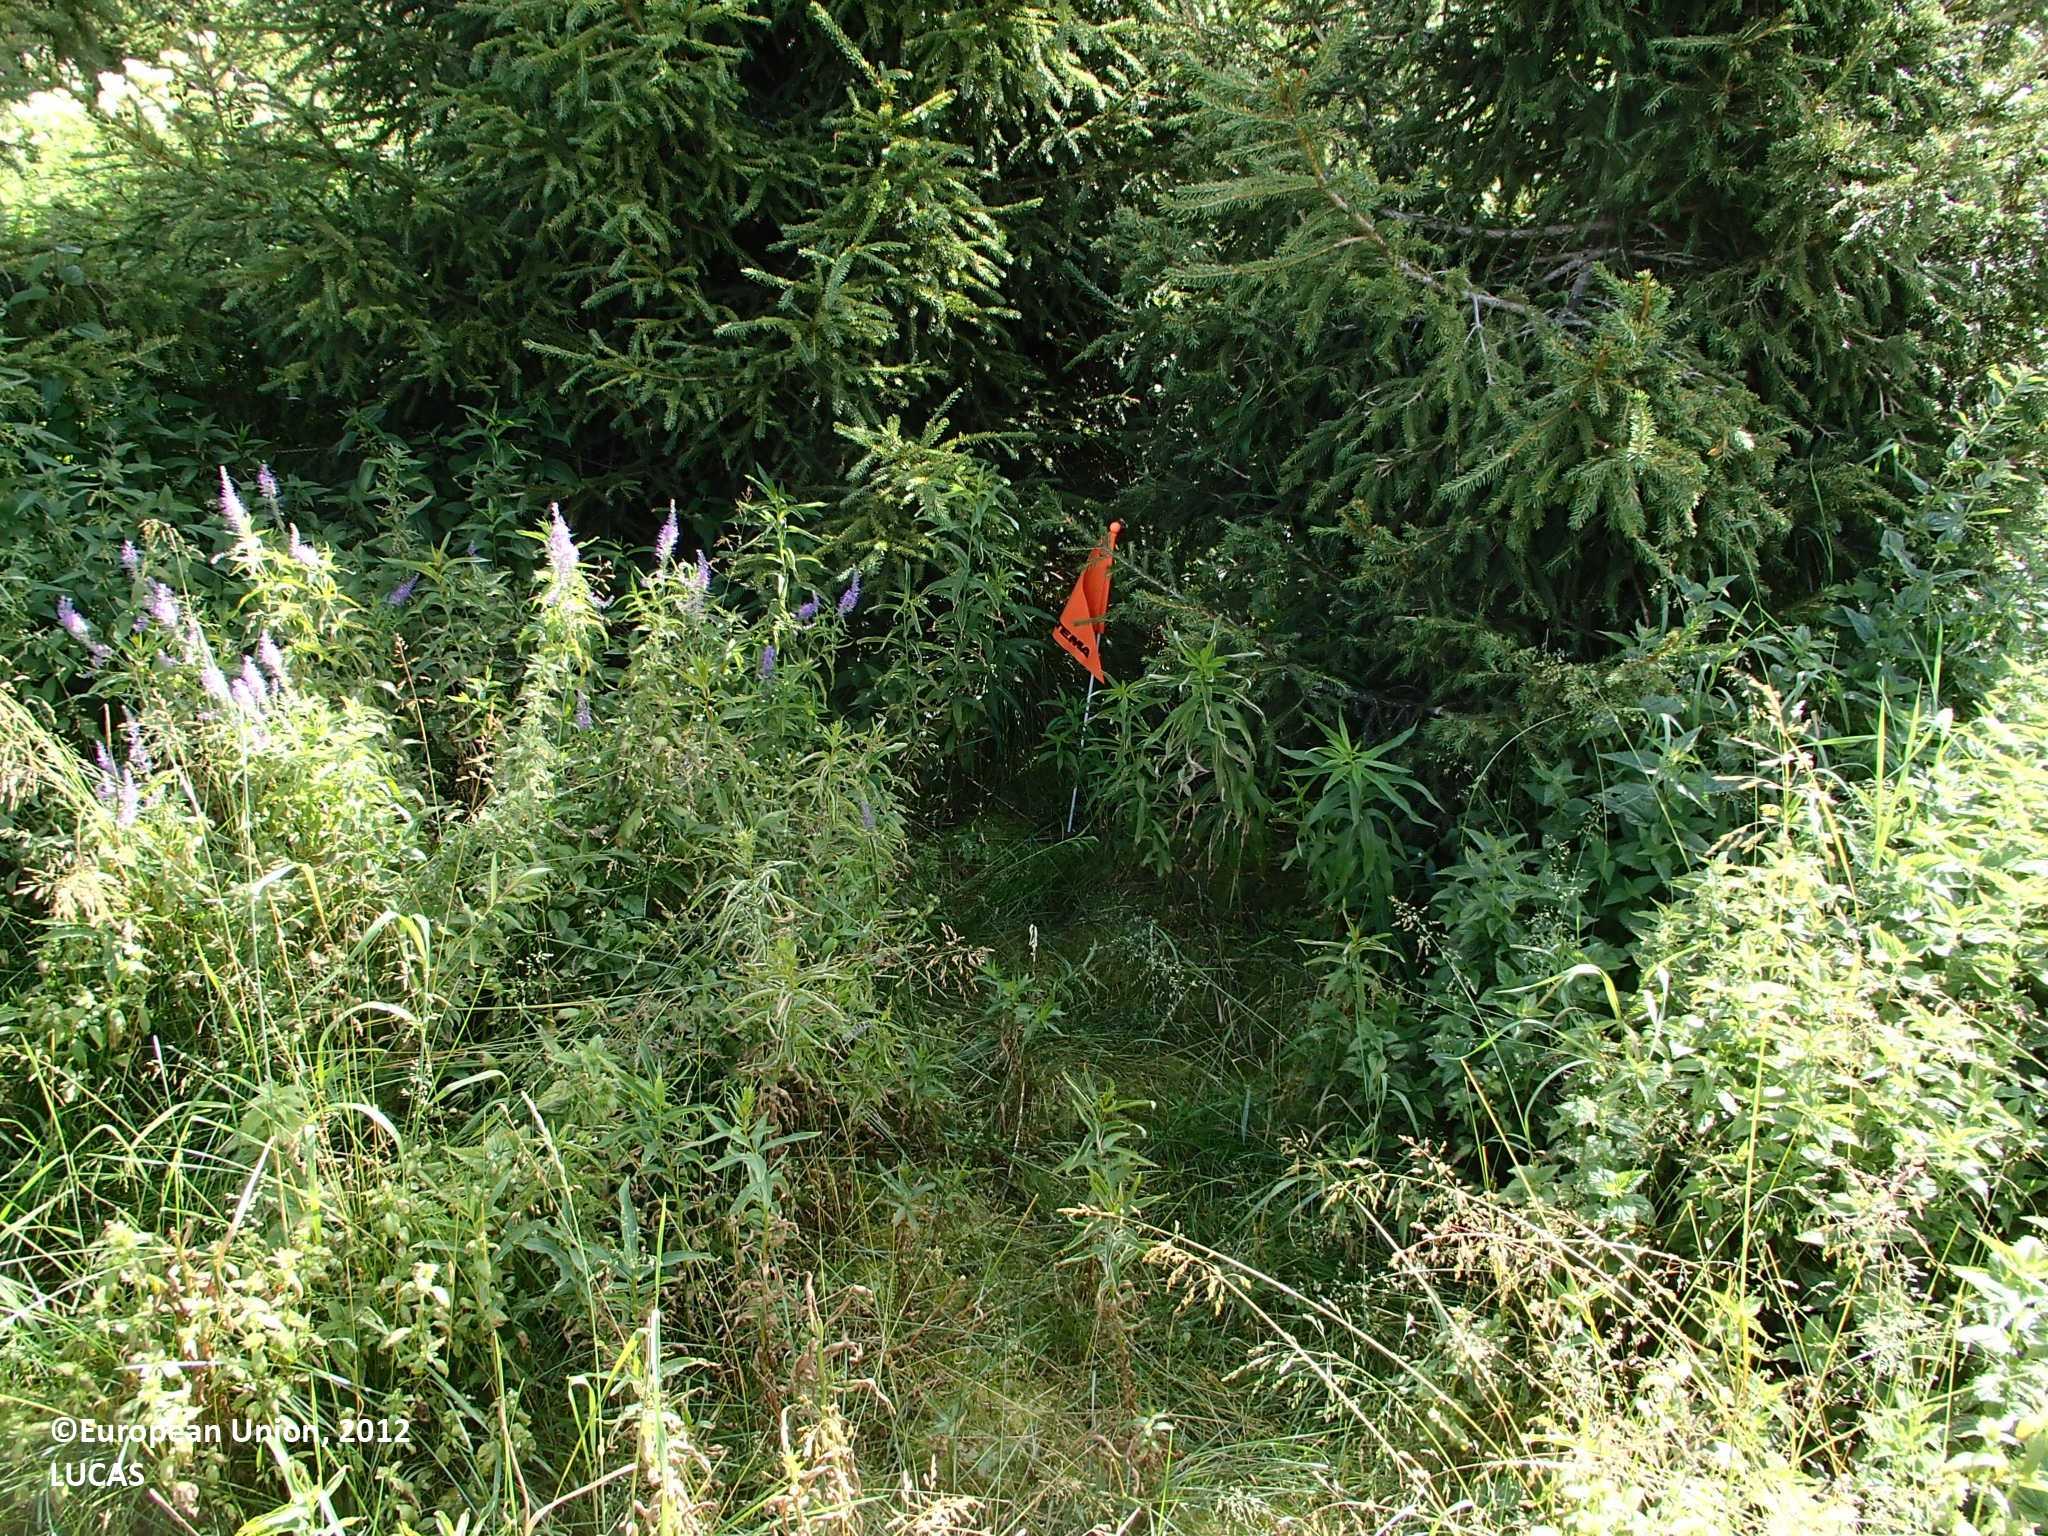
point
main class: Woodland
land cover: Spruce dominated coniferous woodland
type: boreal forest
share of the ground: 25 - 50 %
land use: Forestry
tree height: > 5 m
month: August
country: FI
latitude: 66.2372
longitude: 25.5249
